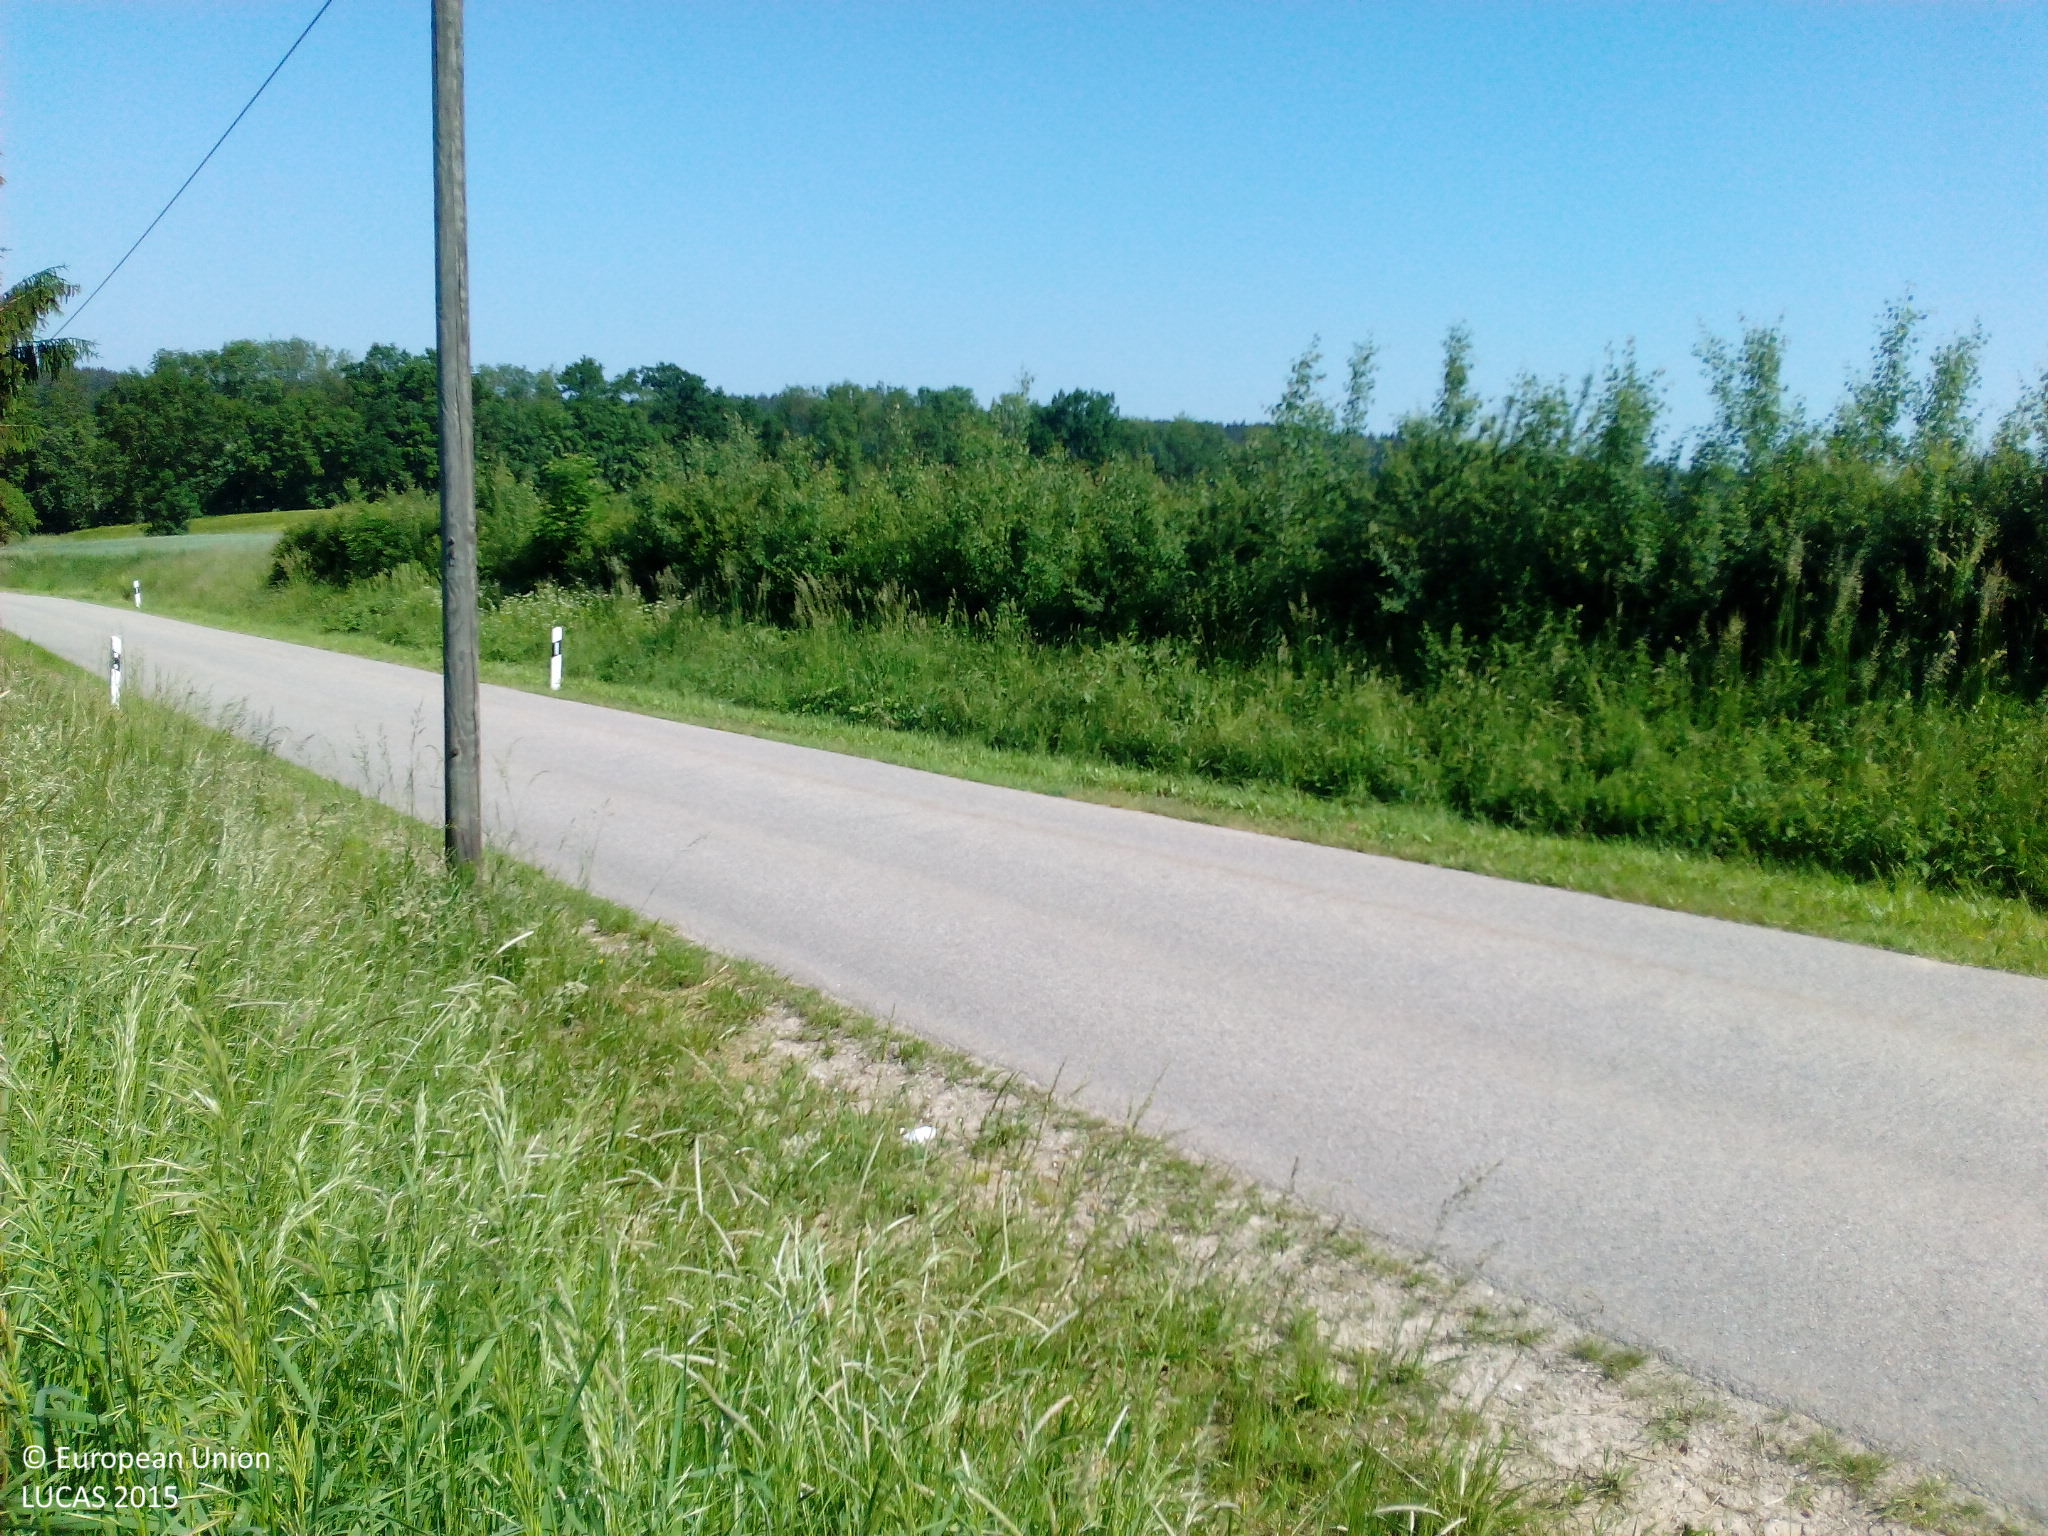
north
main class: Grassland
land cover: Grassland without tree/shrub cover
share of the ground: > 75 %
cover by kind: herbaceous plants 100 %
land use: Agriculture (excluding fallow land and kitchen gardens)
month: June
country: DE
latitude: 48.6834
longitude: 12.4034
